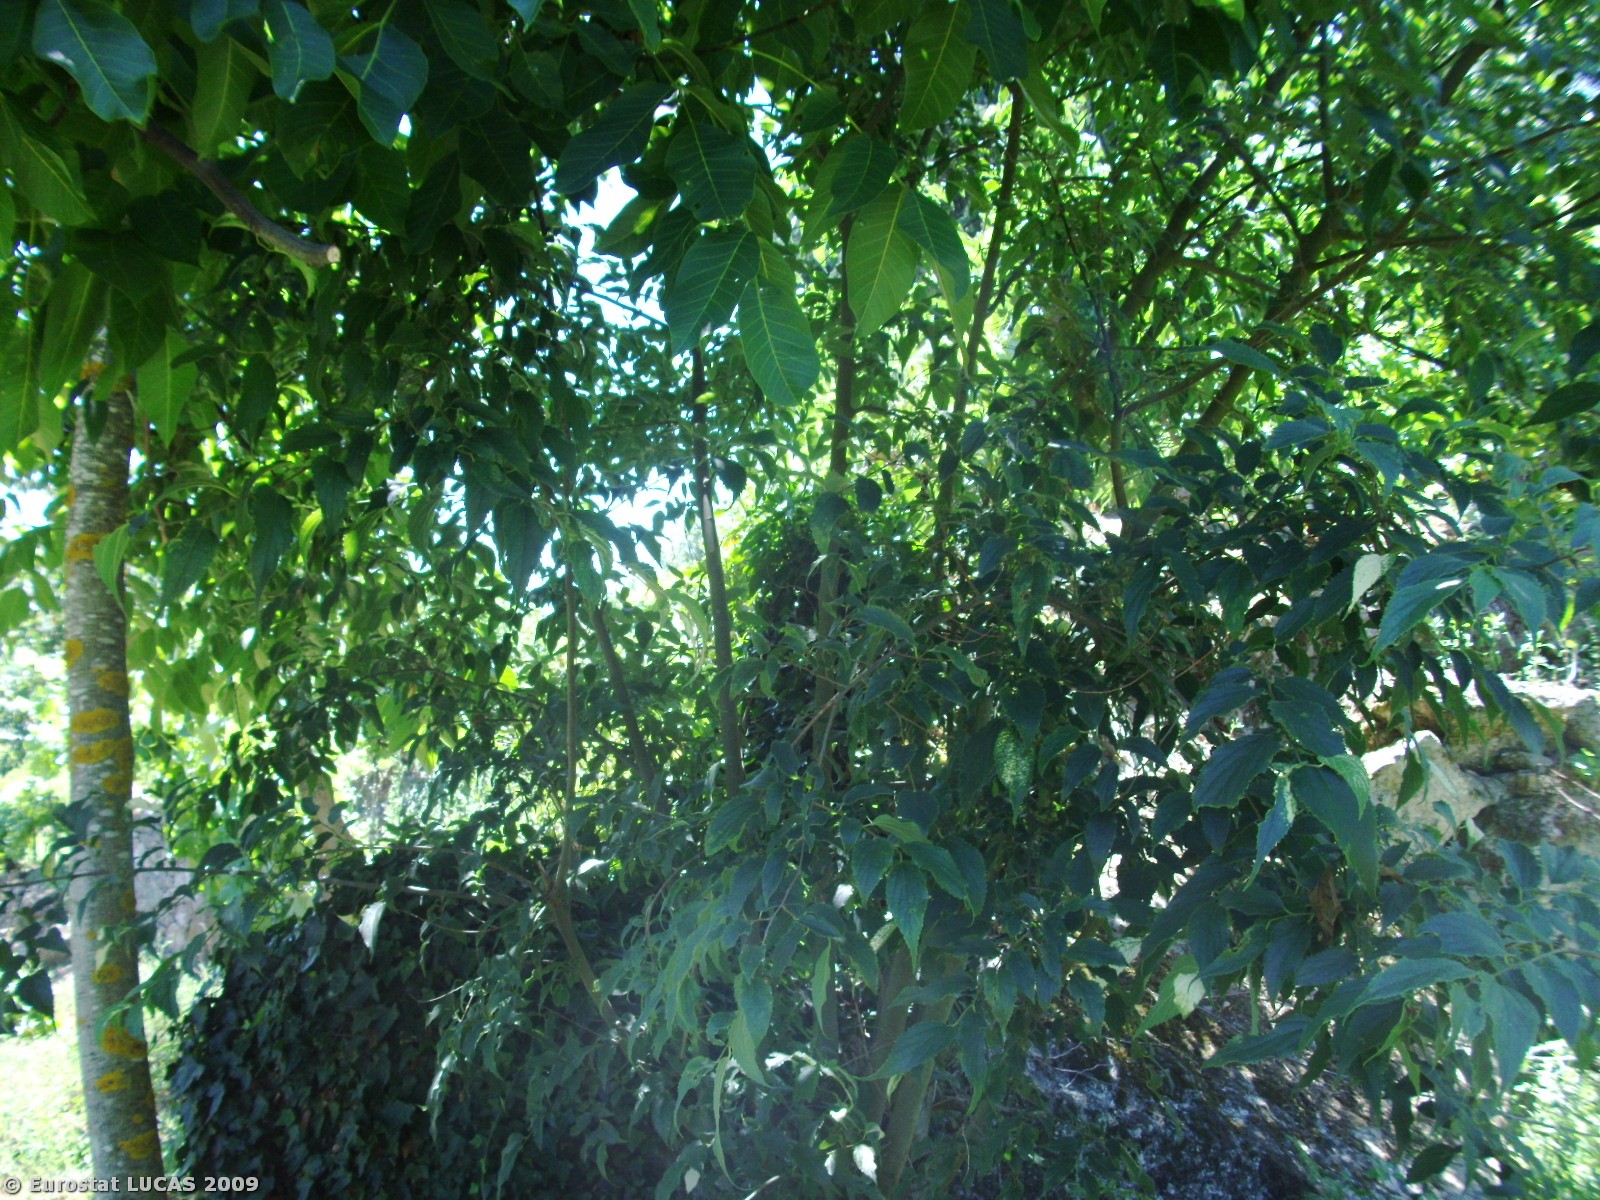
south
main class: Cropland
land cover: Nuts trees
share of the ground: > 75 %
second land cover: Spontaneously vegetated surfaces
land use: Agriculture (excluding fallow land and kitchen gardens)
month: July
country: PT
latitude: 41.0533
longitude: -7.7477
